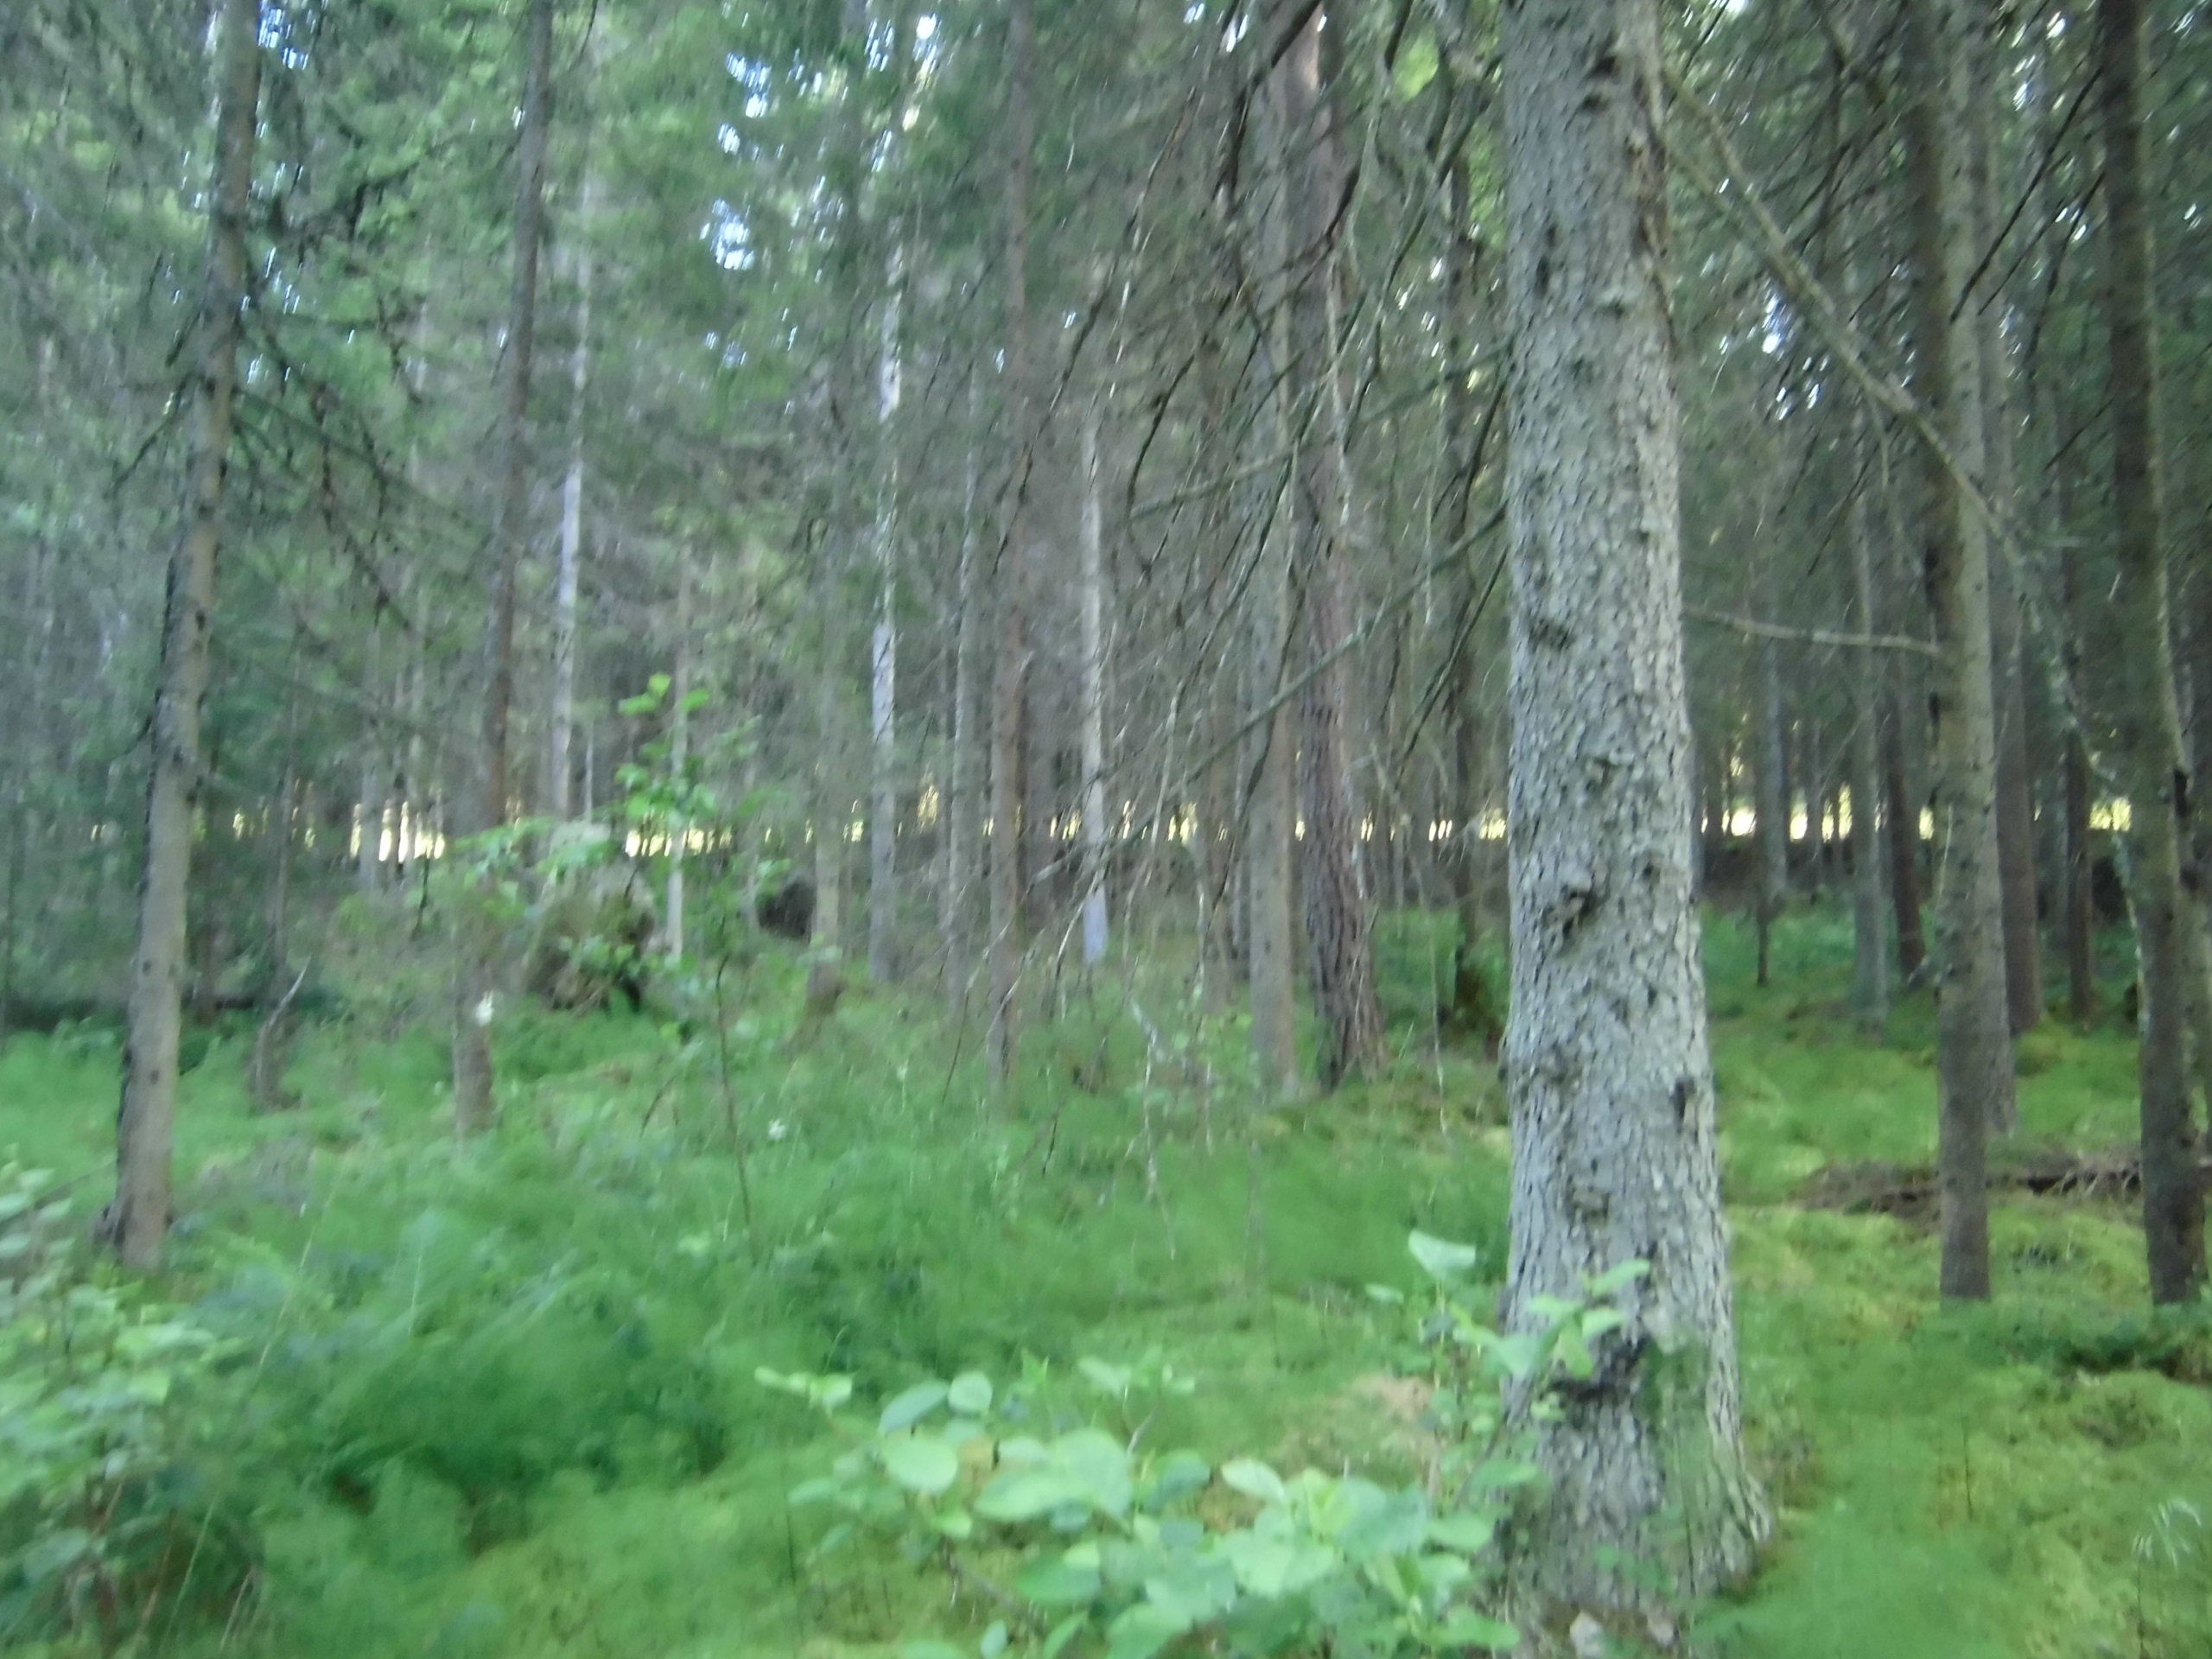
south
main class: Woodland
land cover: Spruce dominated mixed woodland
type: boreal forest
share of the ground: 50 - 75 %
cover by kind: coniferous forest trees 35 %, broadleaved forest trees 25 %, herbaceous plants 20 %, shrubs 10 %, lichens and mosses 10 %
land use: Forestry
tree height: > 5 m
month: July
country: SE
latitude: 57.3964
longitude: 15.2383
